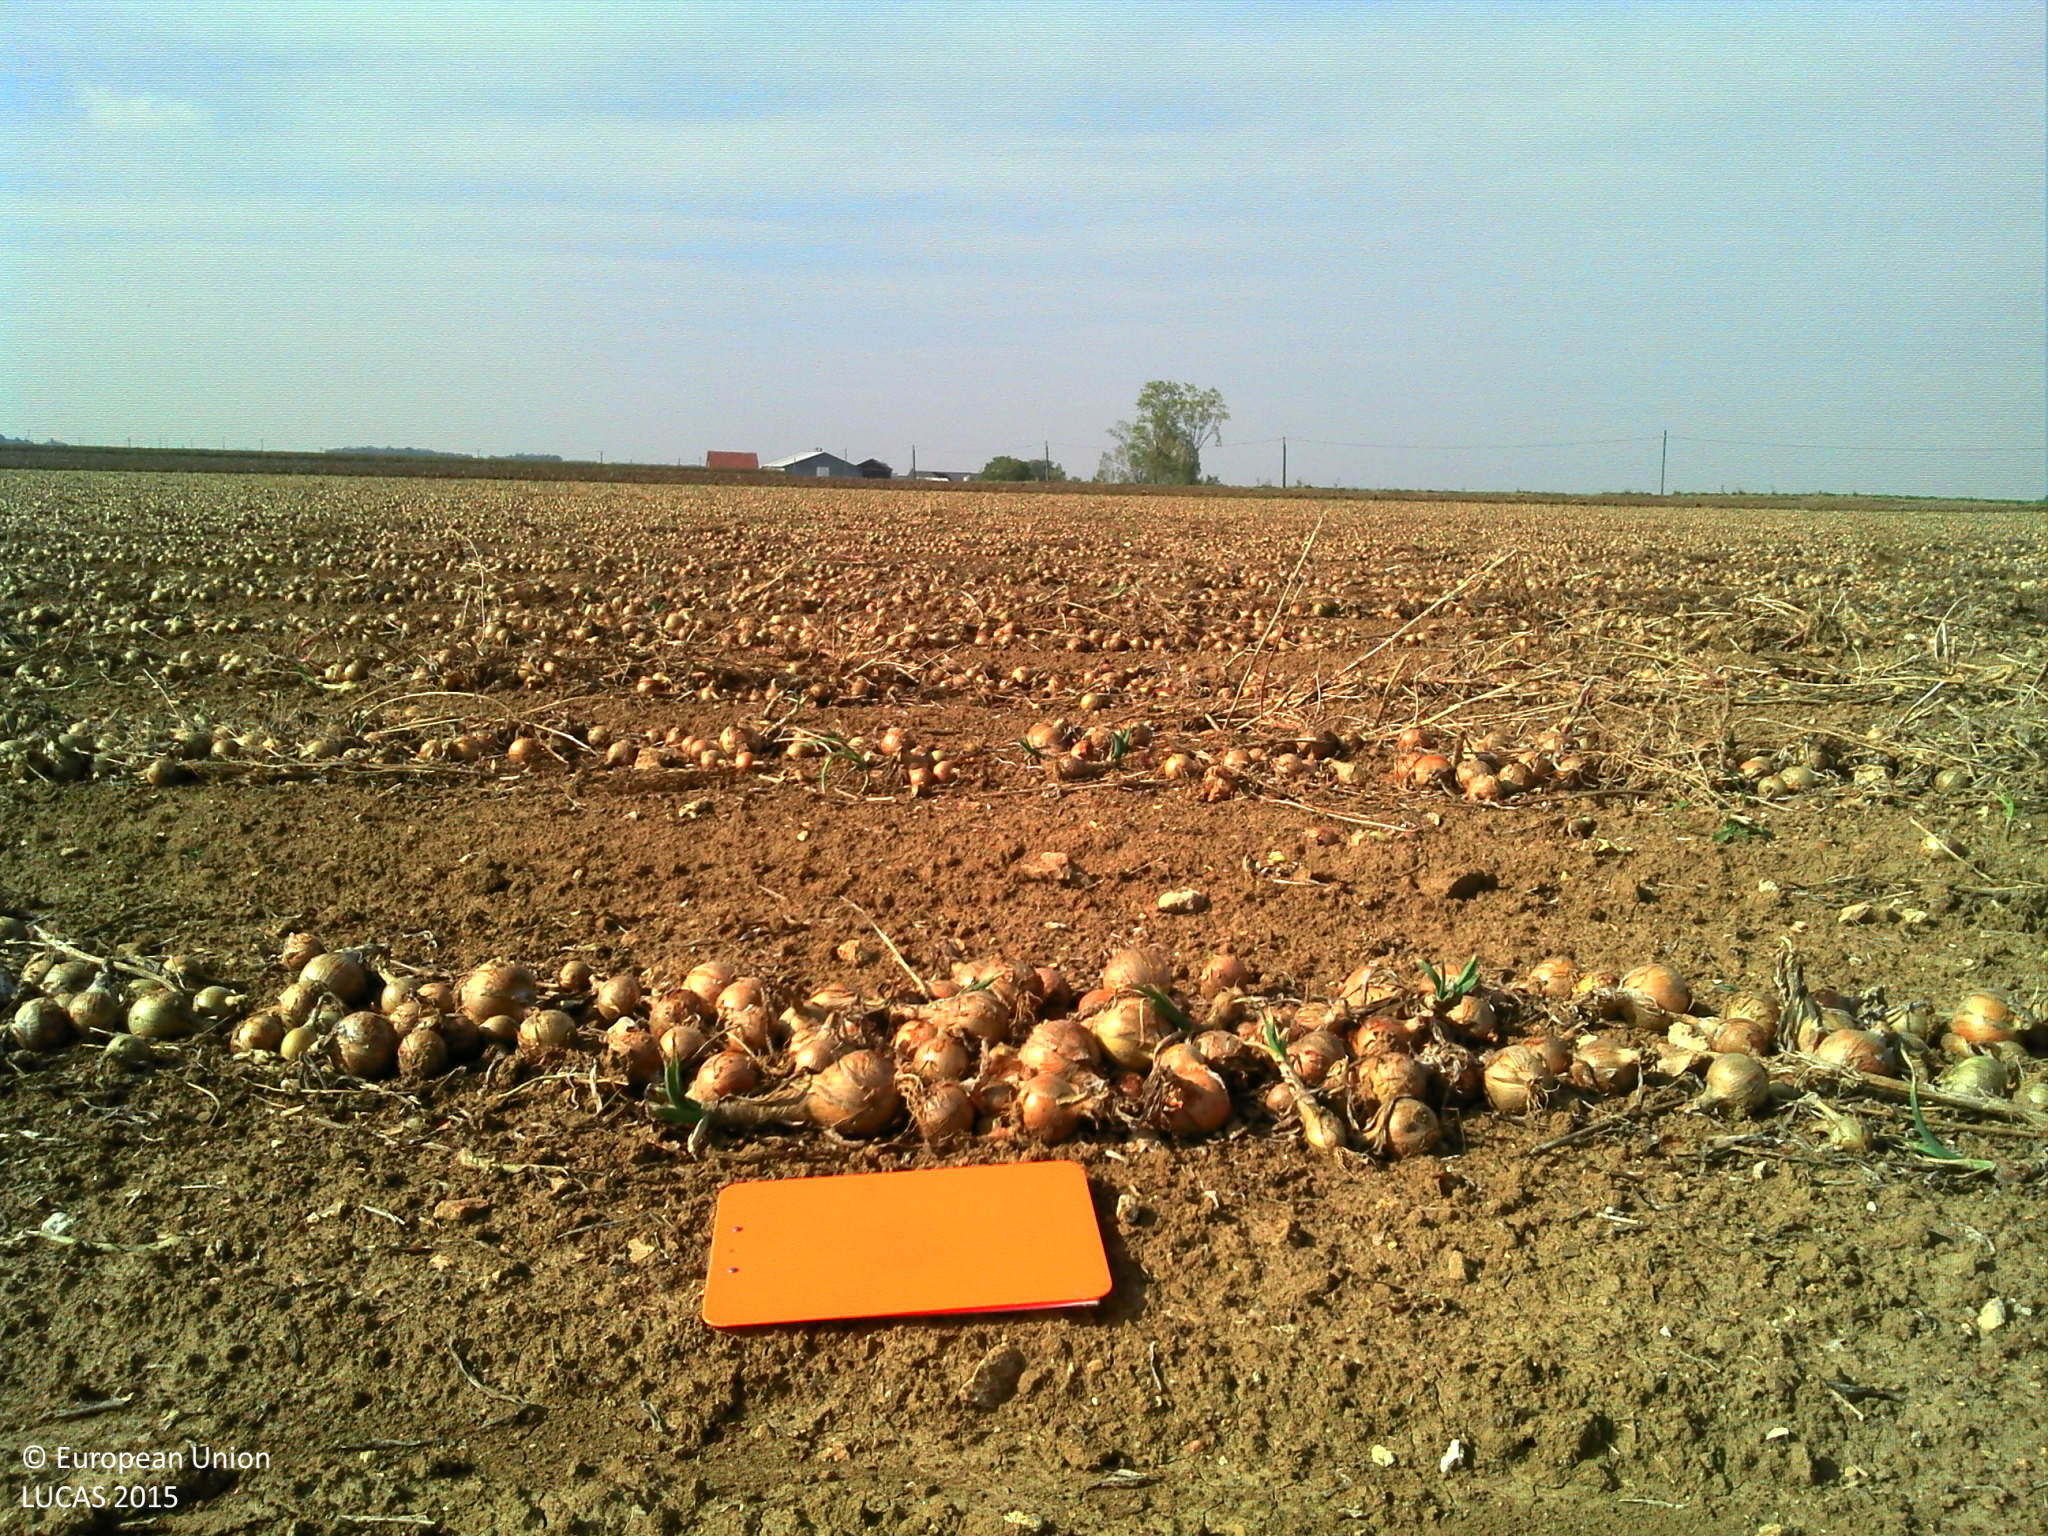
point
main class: Cropland
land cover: Other root crops
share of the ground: 25 - 50 %
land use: Agriculture (excluding fallow land and kitchen gardens)
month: October
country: FR
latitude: 47.8123
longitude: 1.3706
